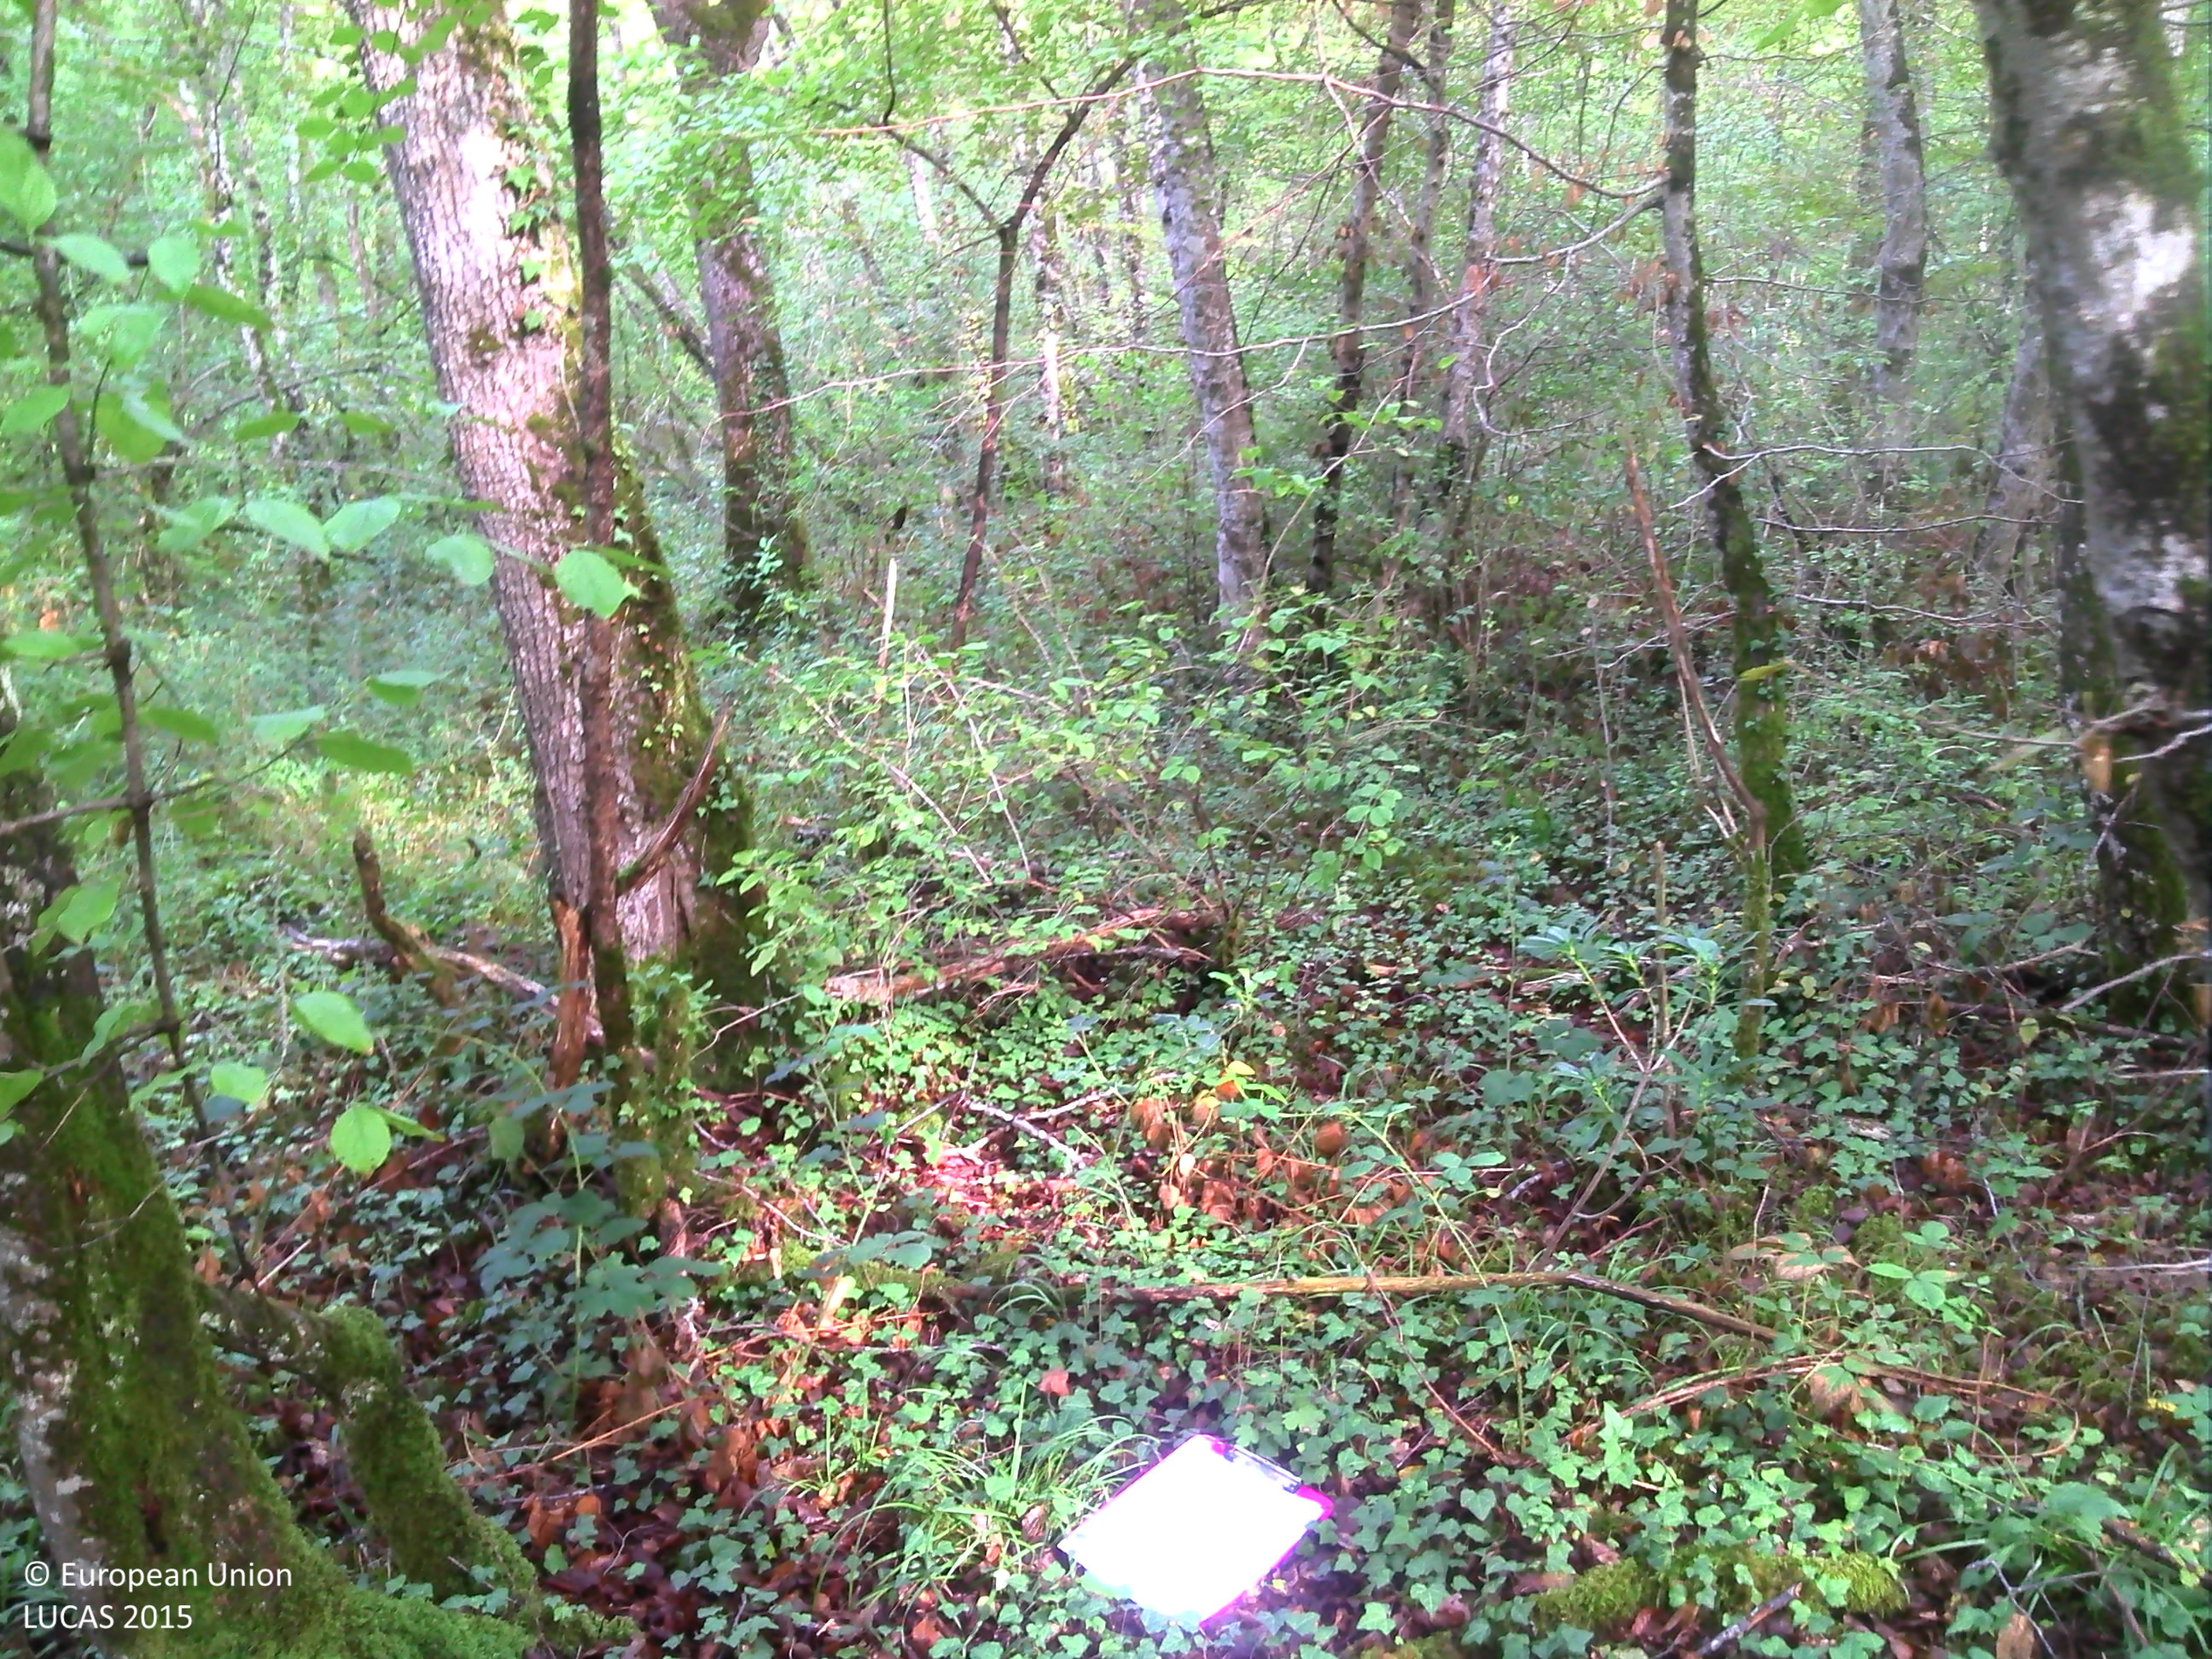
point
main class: Woodland
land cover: Broadleaved woodland
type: mesophytic deciduous forest
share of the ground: > 75 %
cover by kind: broadleaved forest trees 90 %, herbaceous plants 5 %, lichens and mosses 5 %
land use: Forestry
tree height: > 5 m
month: September
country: FR
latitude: 48.1330
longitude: 4.7176
